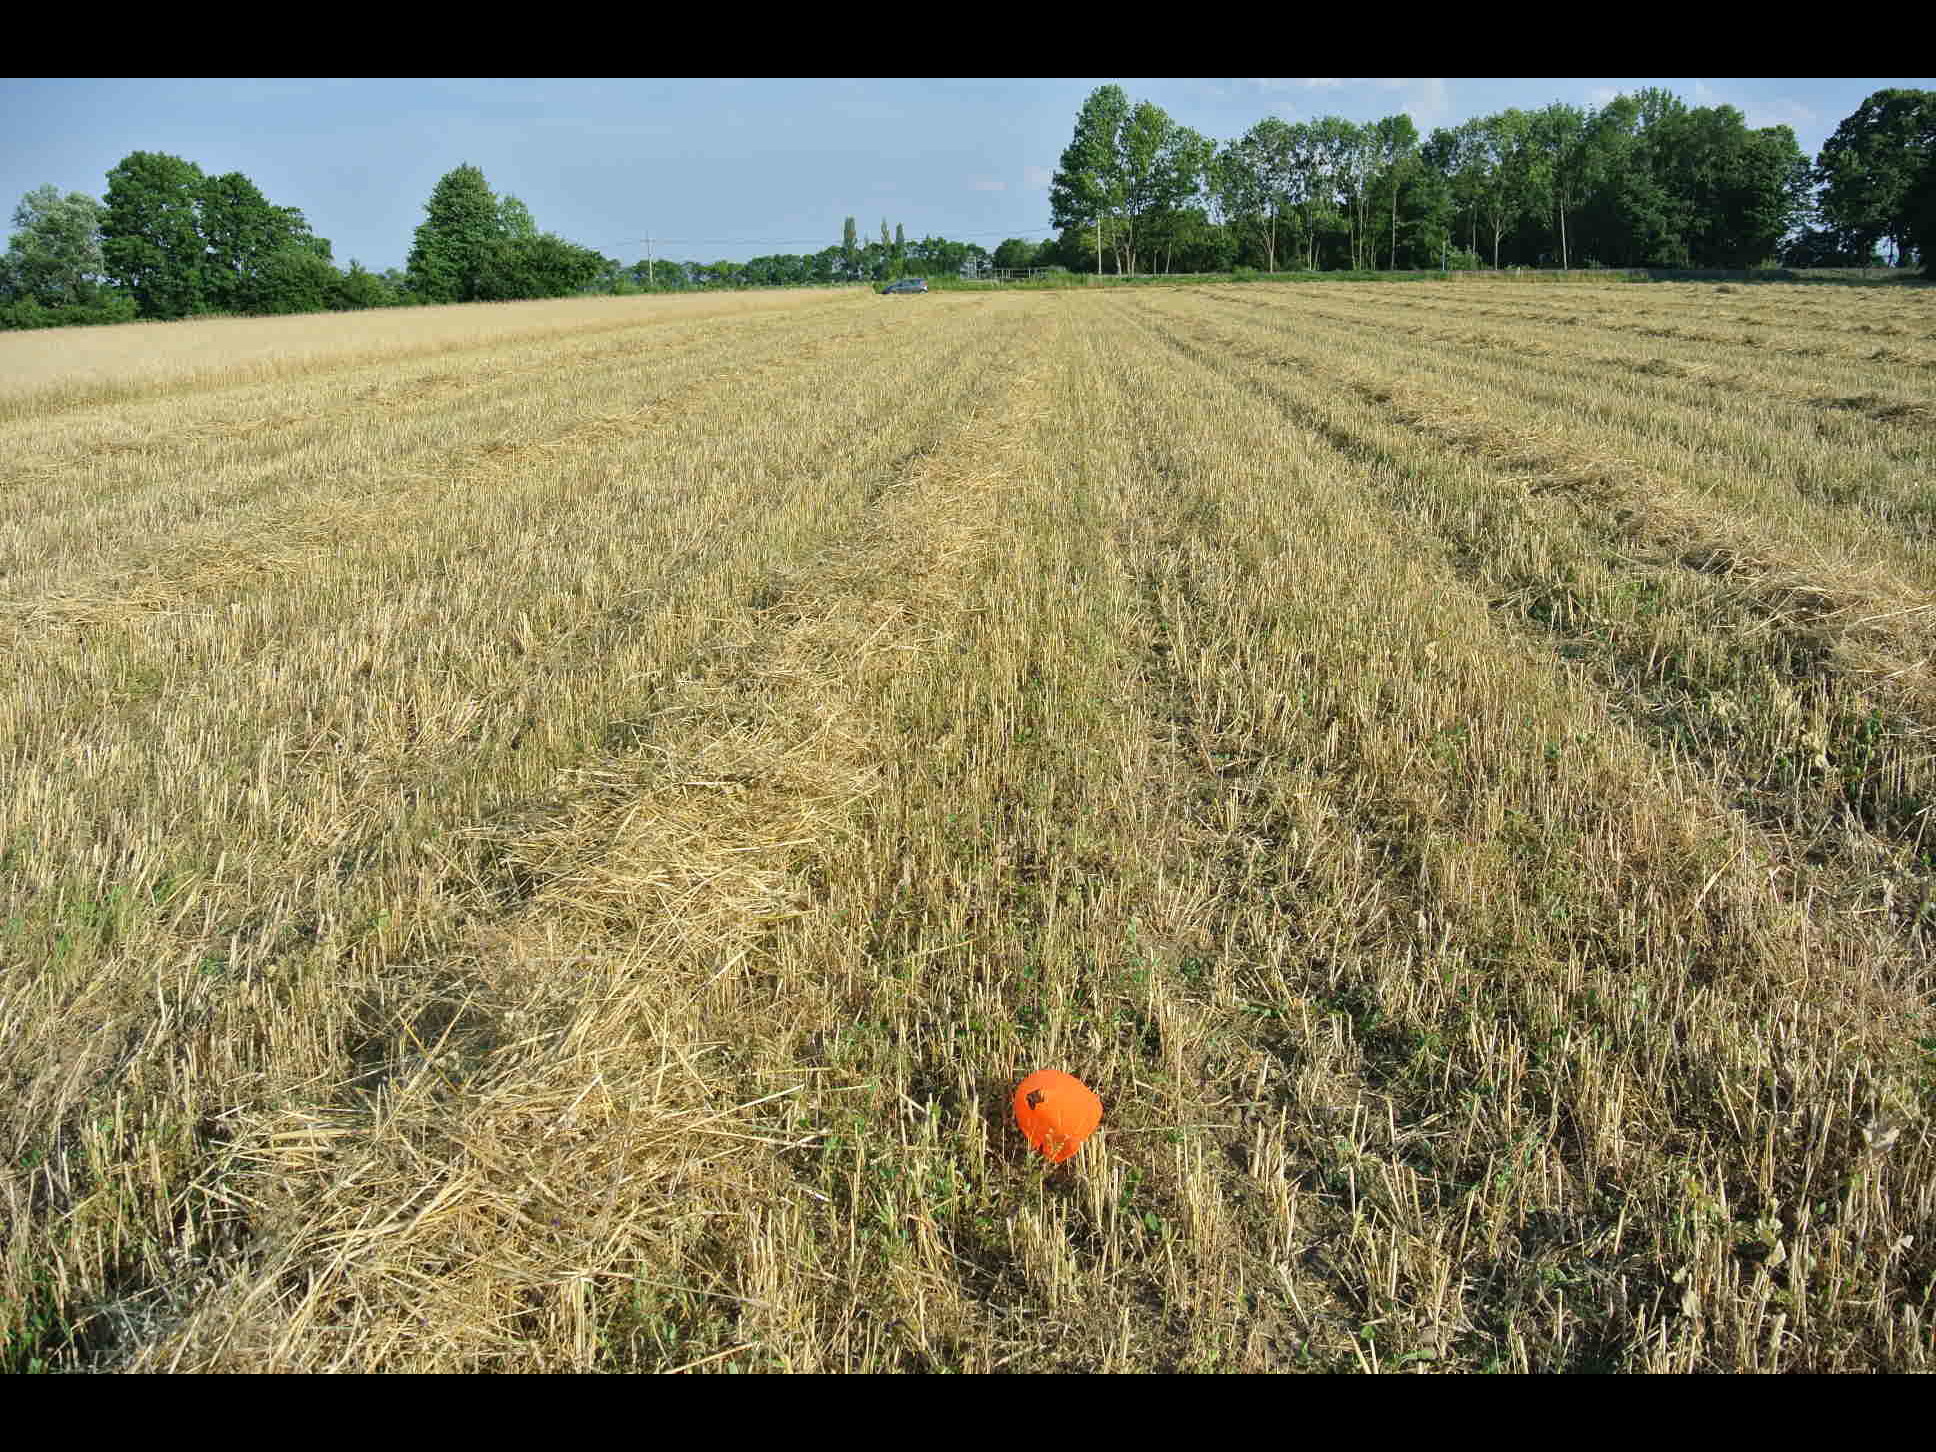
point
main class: Cropland
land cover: Oats
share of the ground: > 75 %
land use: Agriculture (excluding fallow land and kitchen gardens)
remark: Harvested field
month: July
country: AT
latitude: 47.8181
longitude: 16.1337
